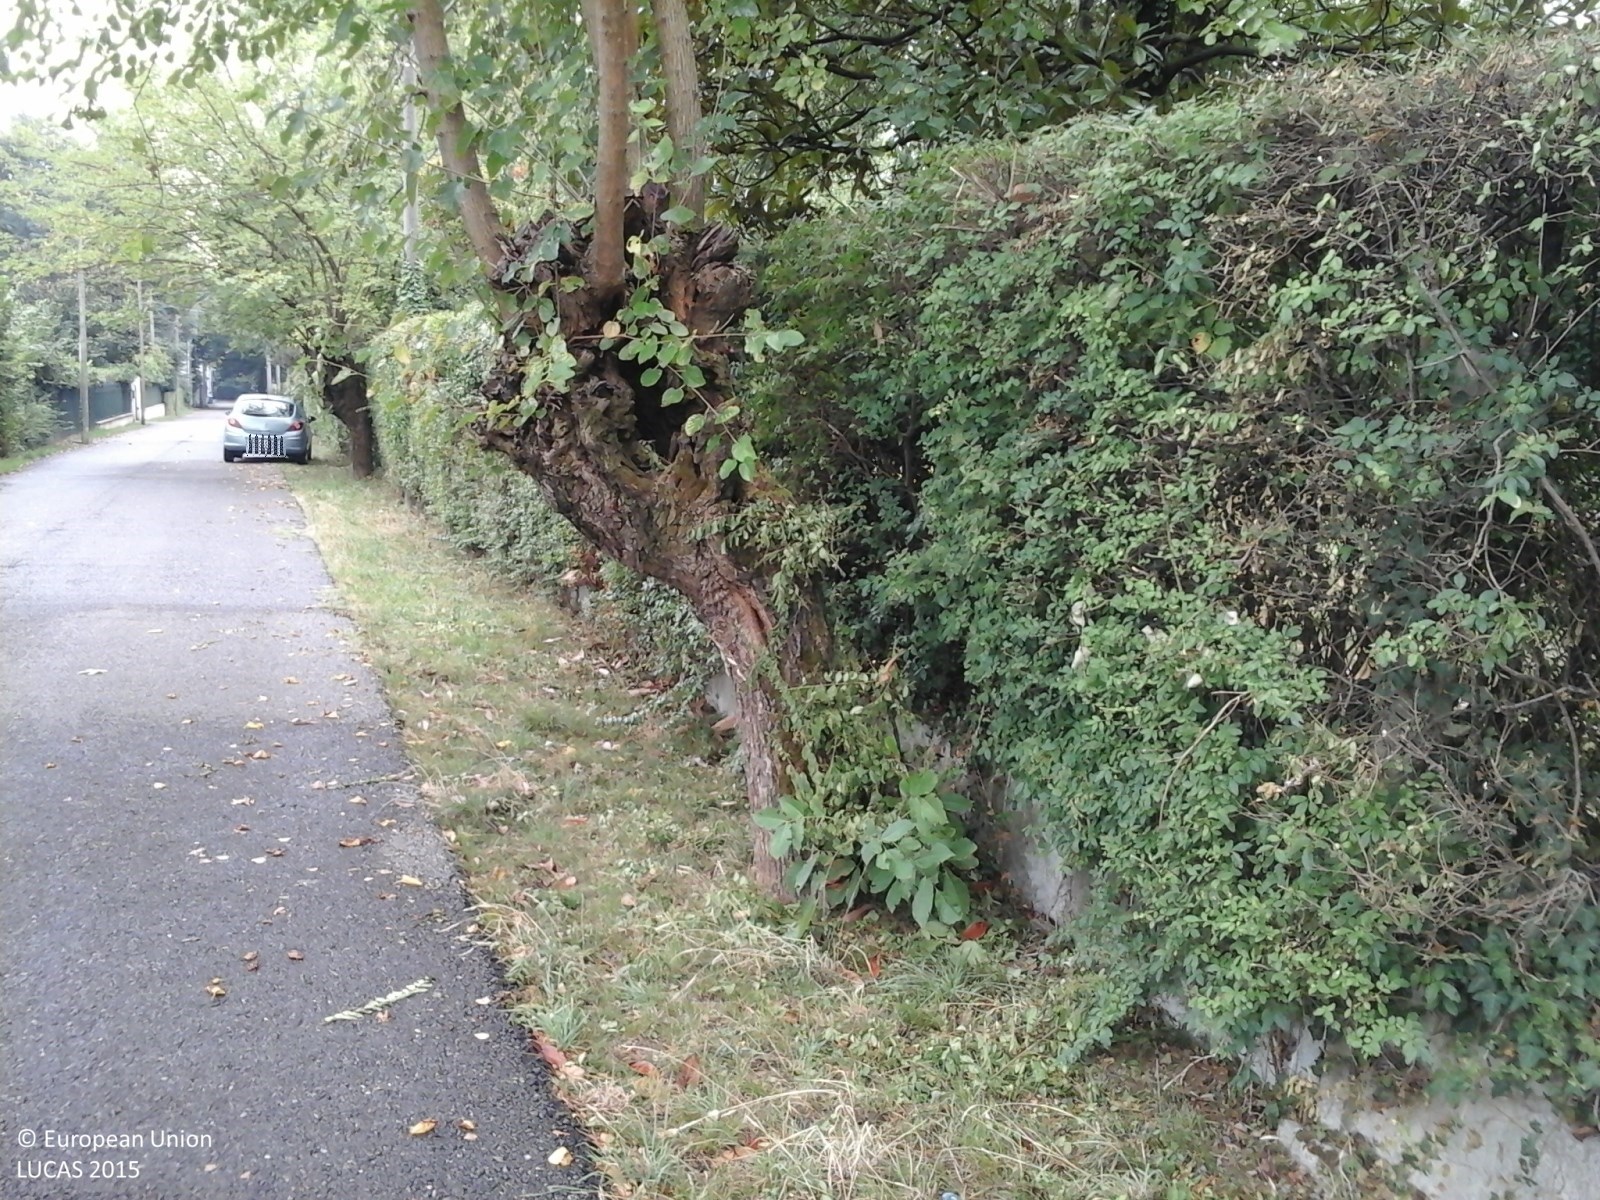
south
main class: Grassland
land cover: Grassland without tree/shrub cover
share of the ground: > 75 %
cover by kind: herbaceous plants 100 %
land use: Residential
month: August
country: IT
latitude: 45.6629
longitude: 9.1158
